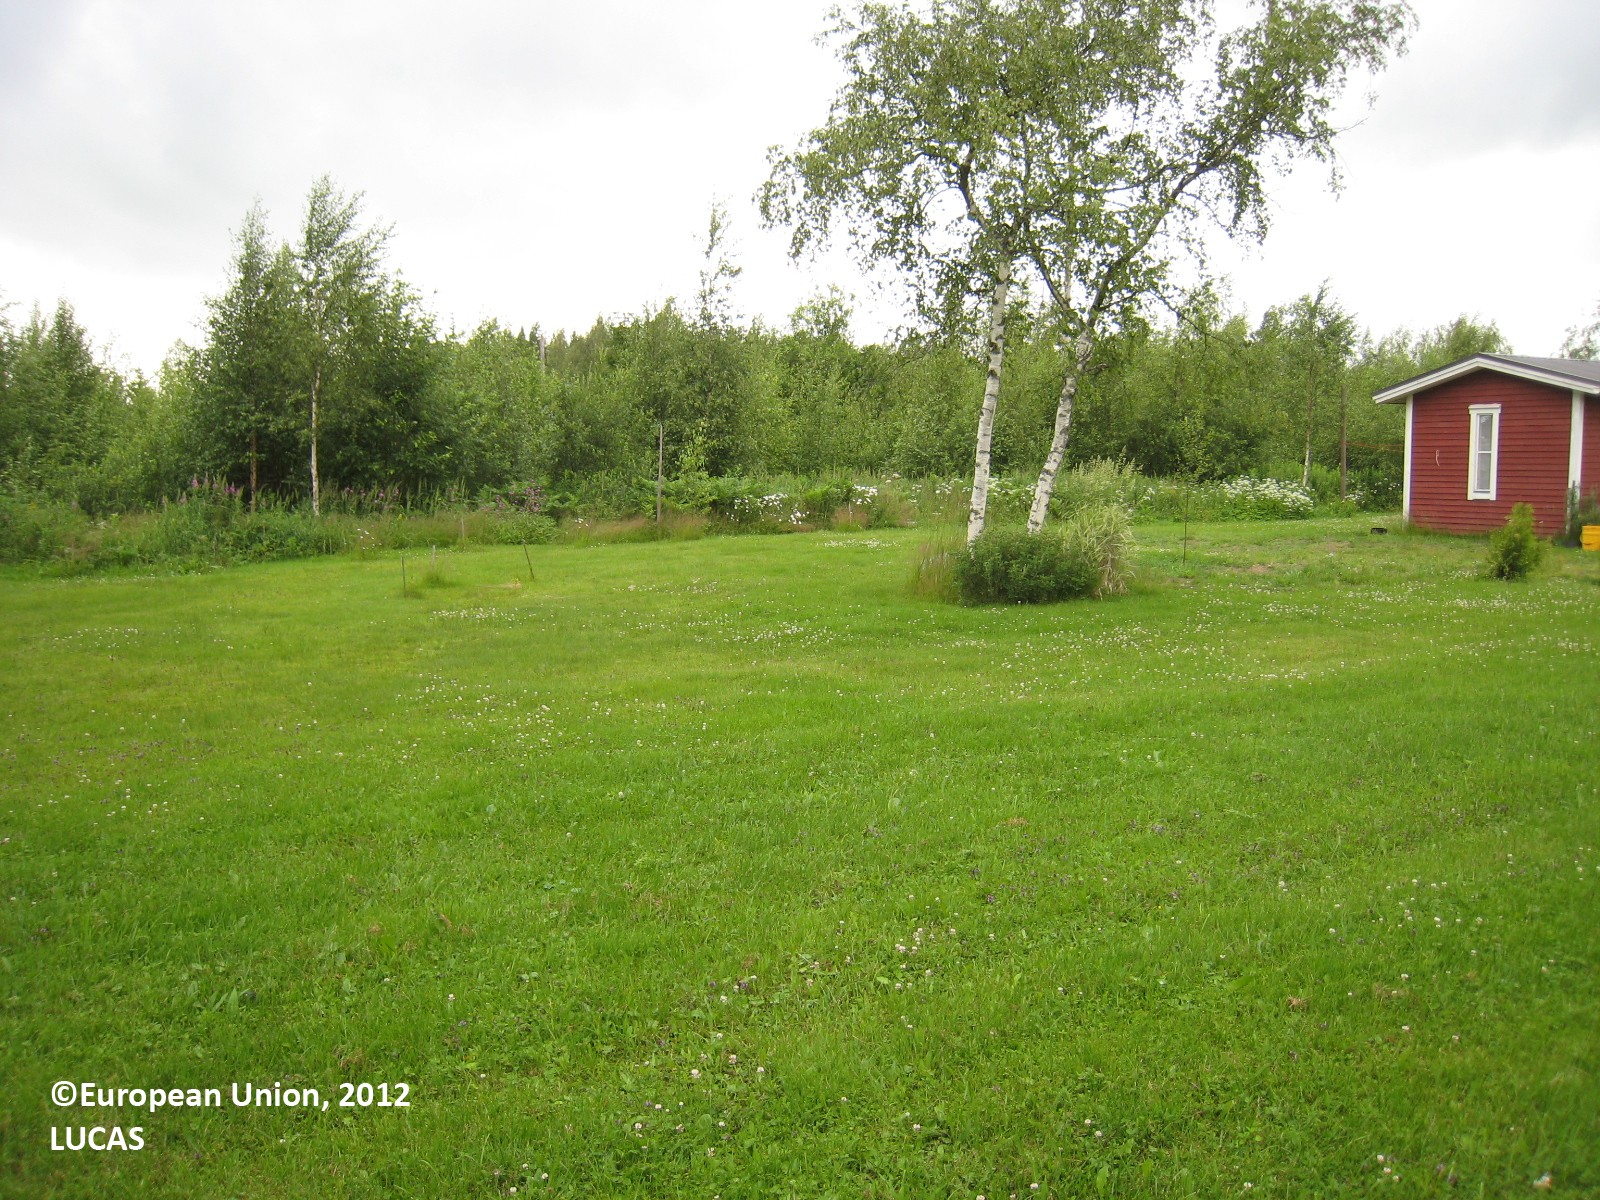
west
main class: Grassland
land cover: Grassland with sparse tree/shrub cover
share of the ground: > 75 %
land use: Residential
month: July
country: FI
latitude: 61.8284
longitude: 27.3922
